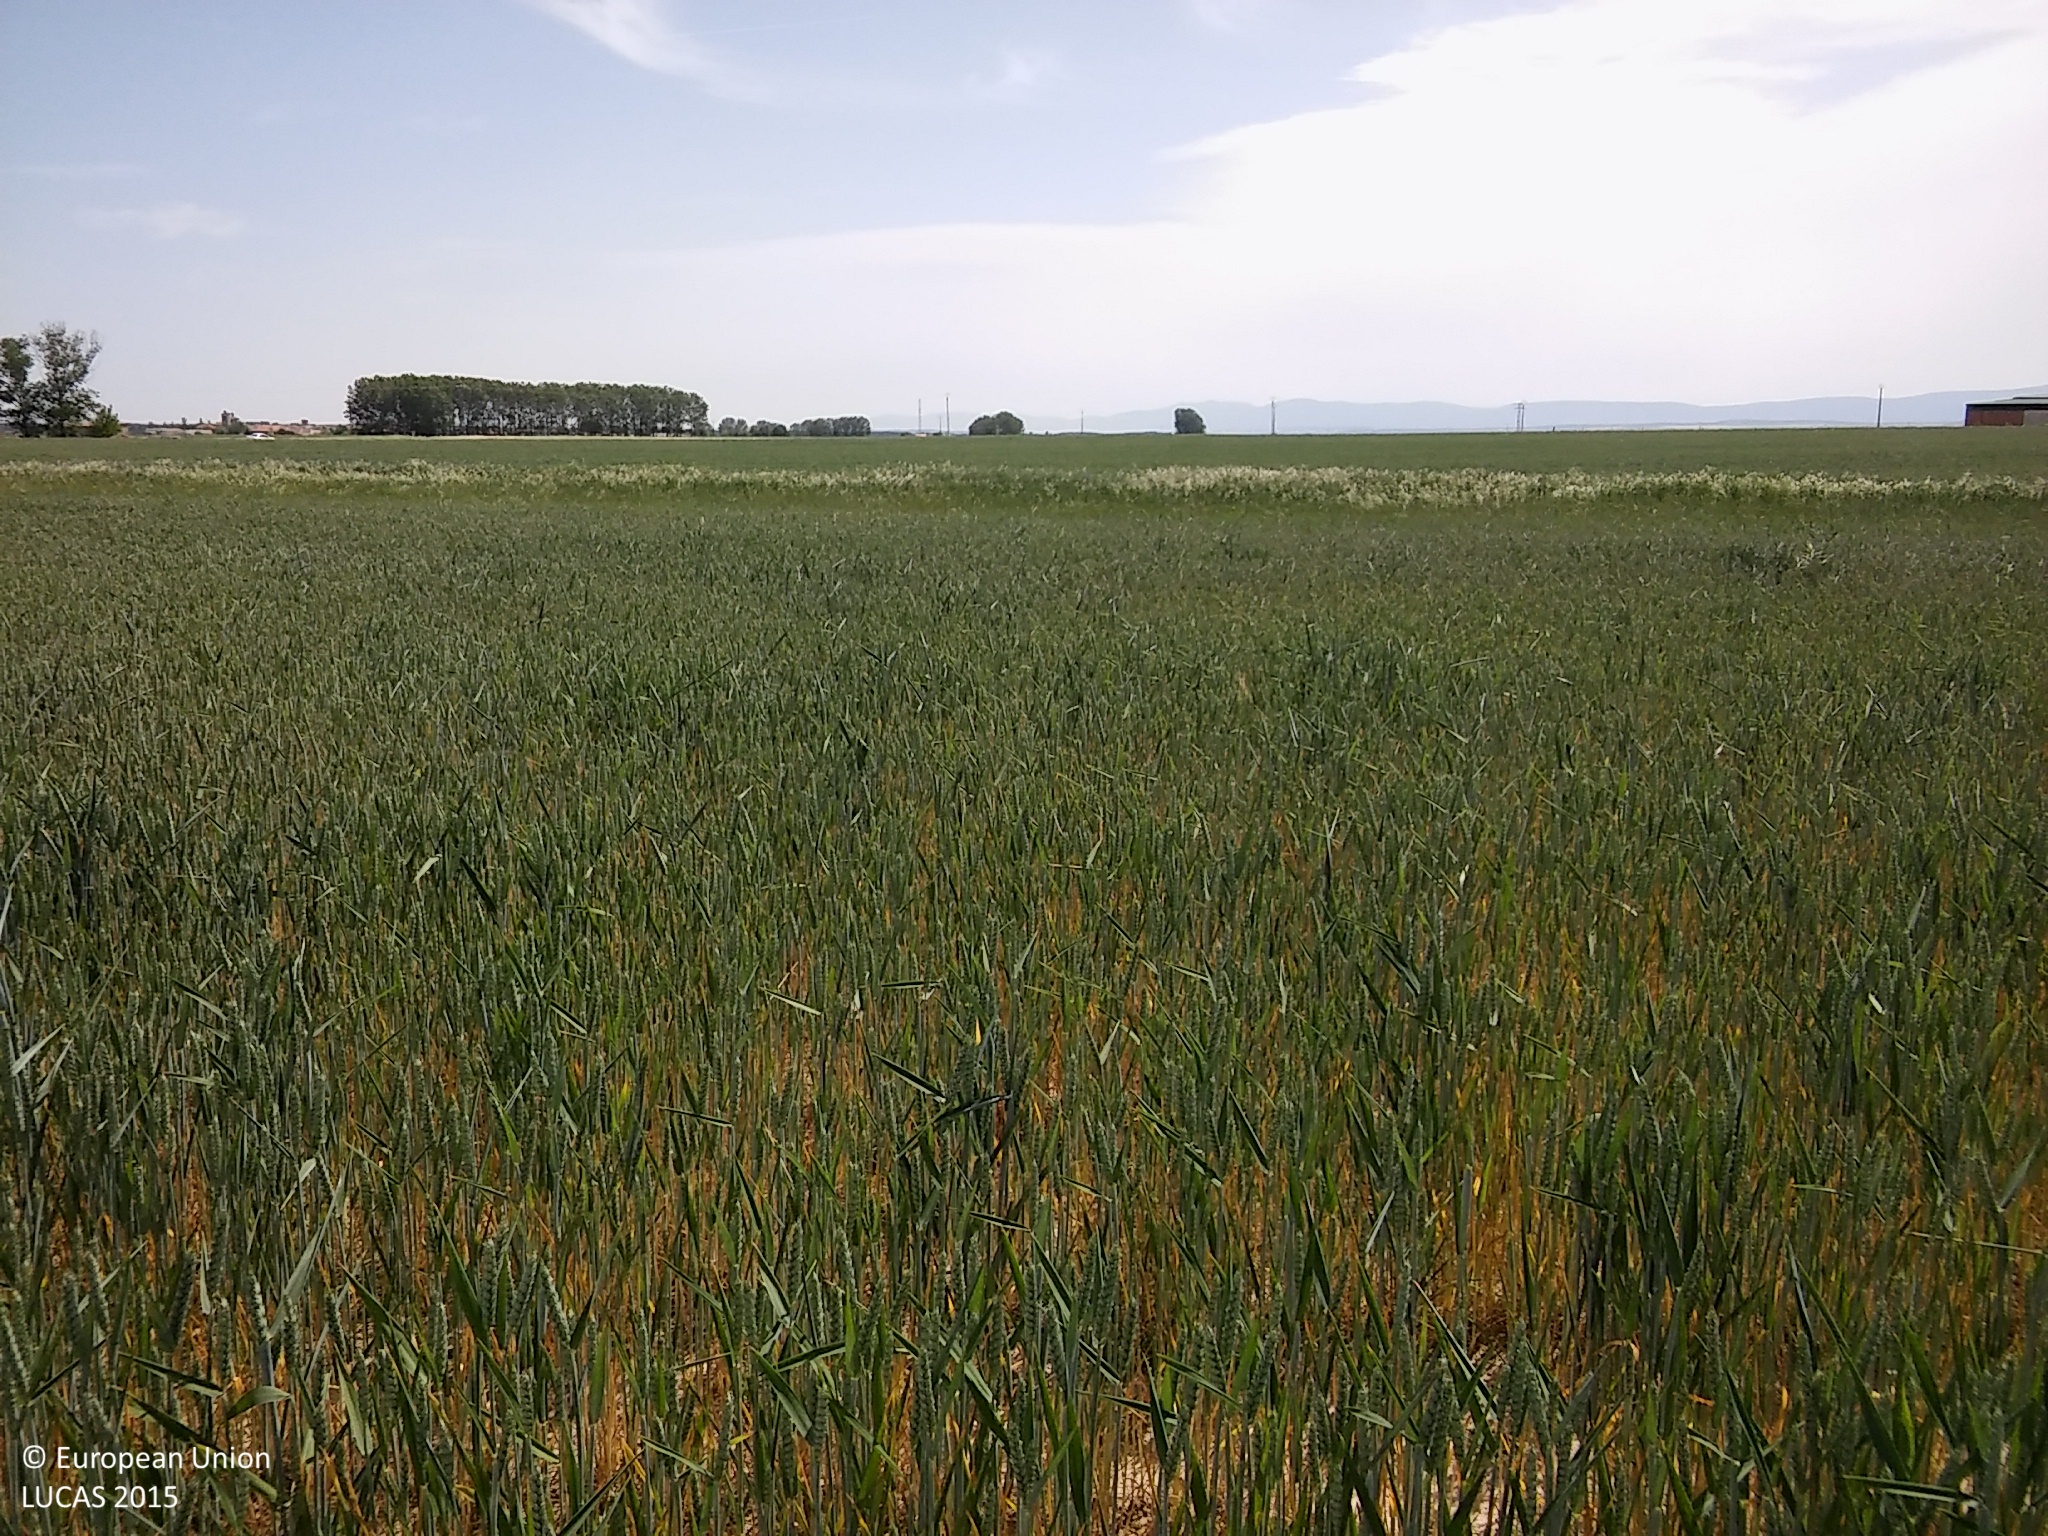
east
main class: Cropland
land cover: Common wheat
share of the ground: 50 - 75 %
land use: Agriculture (excluding fallow land and kitchen gardens)
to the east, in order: Common wheat; Grass margins; Ditches and canals; Grass margins; Common wheat; Grass margins
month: May
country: ES
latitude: 41.1881
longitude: -4.0855
